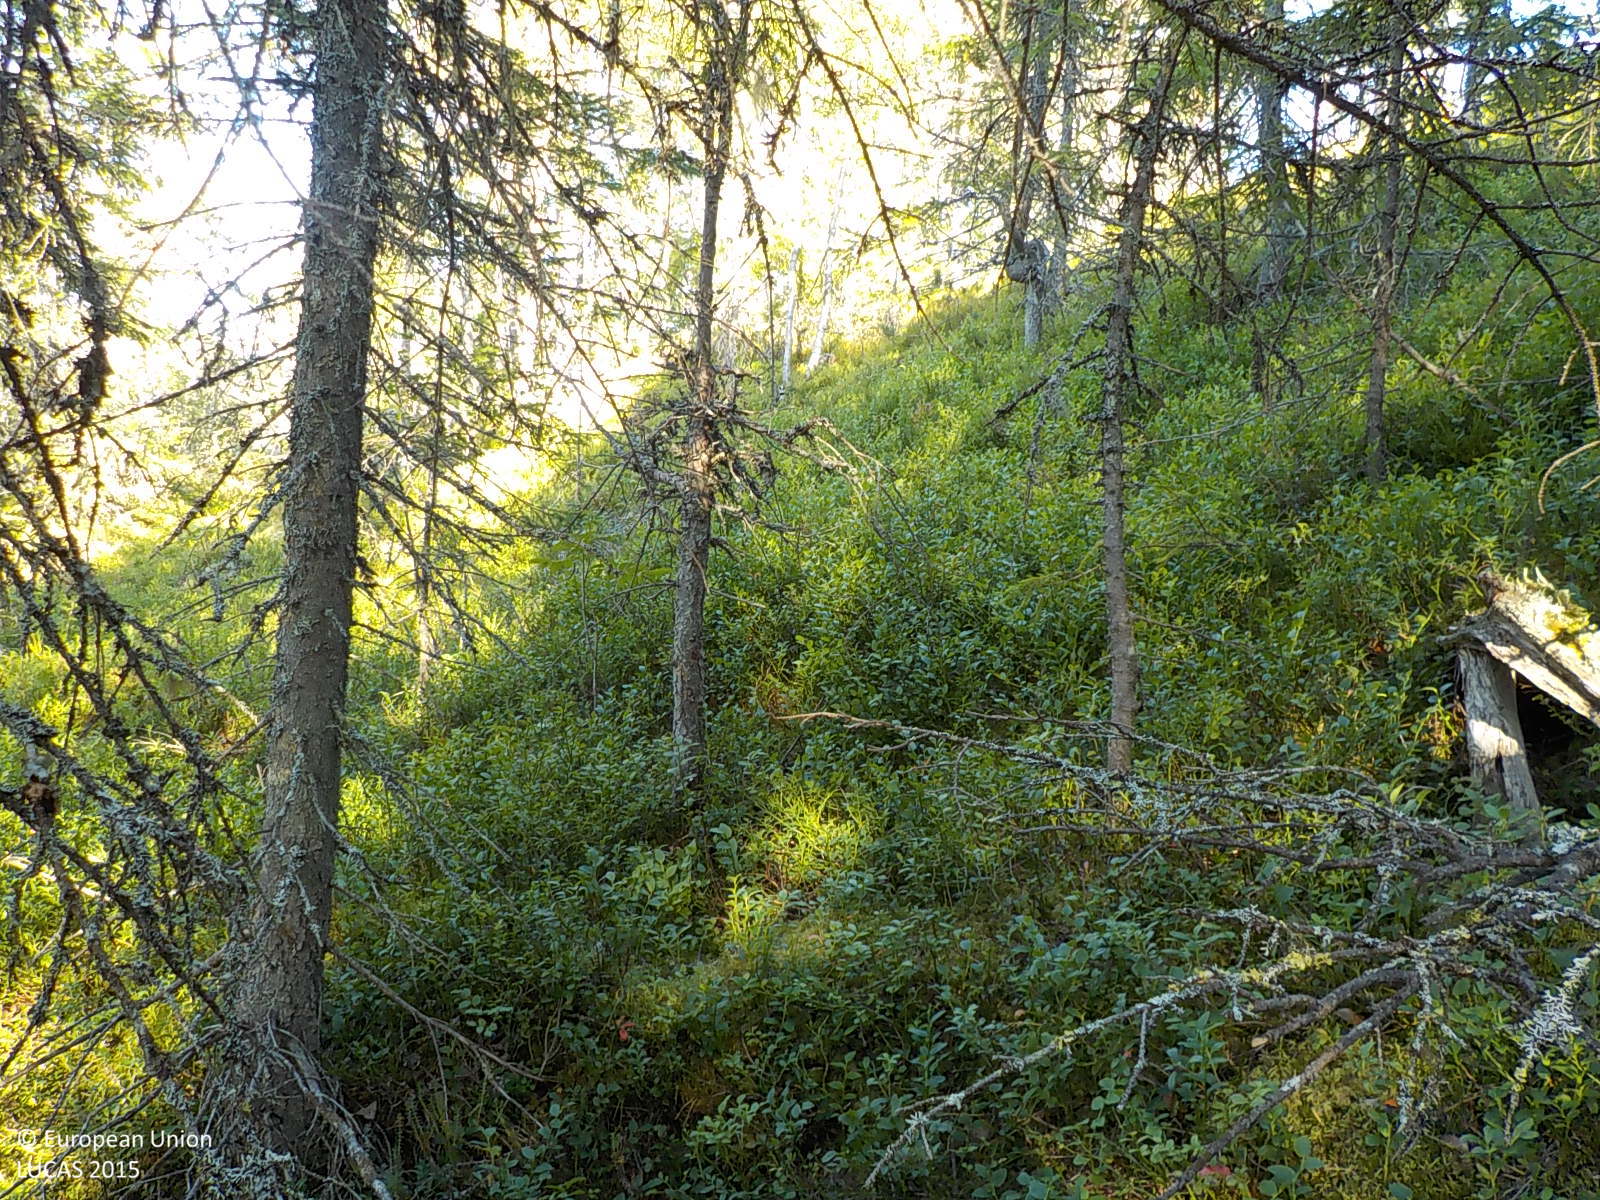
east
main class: Woodland
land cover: Spruce dominated coniferous woodland
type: boreal forest
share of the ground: 50 - 75 %
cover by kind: coniferous forest trees 75 %, shrubs 25 %
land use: Forestry
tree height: > 5 m
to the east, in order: Spruce dominated coniferous woodland; Pine dominated coniferous woodland; Spruce dominated coniferous woodland; Pine dominated coniferous woodland
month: August
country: SE
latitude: 63.3720
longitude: 18.7973
